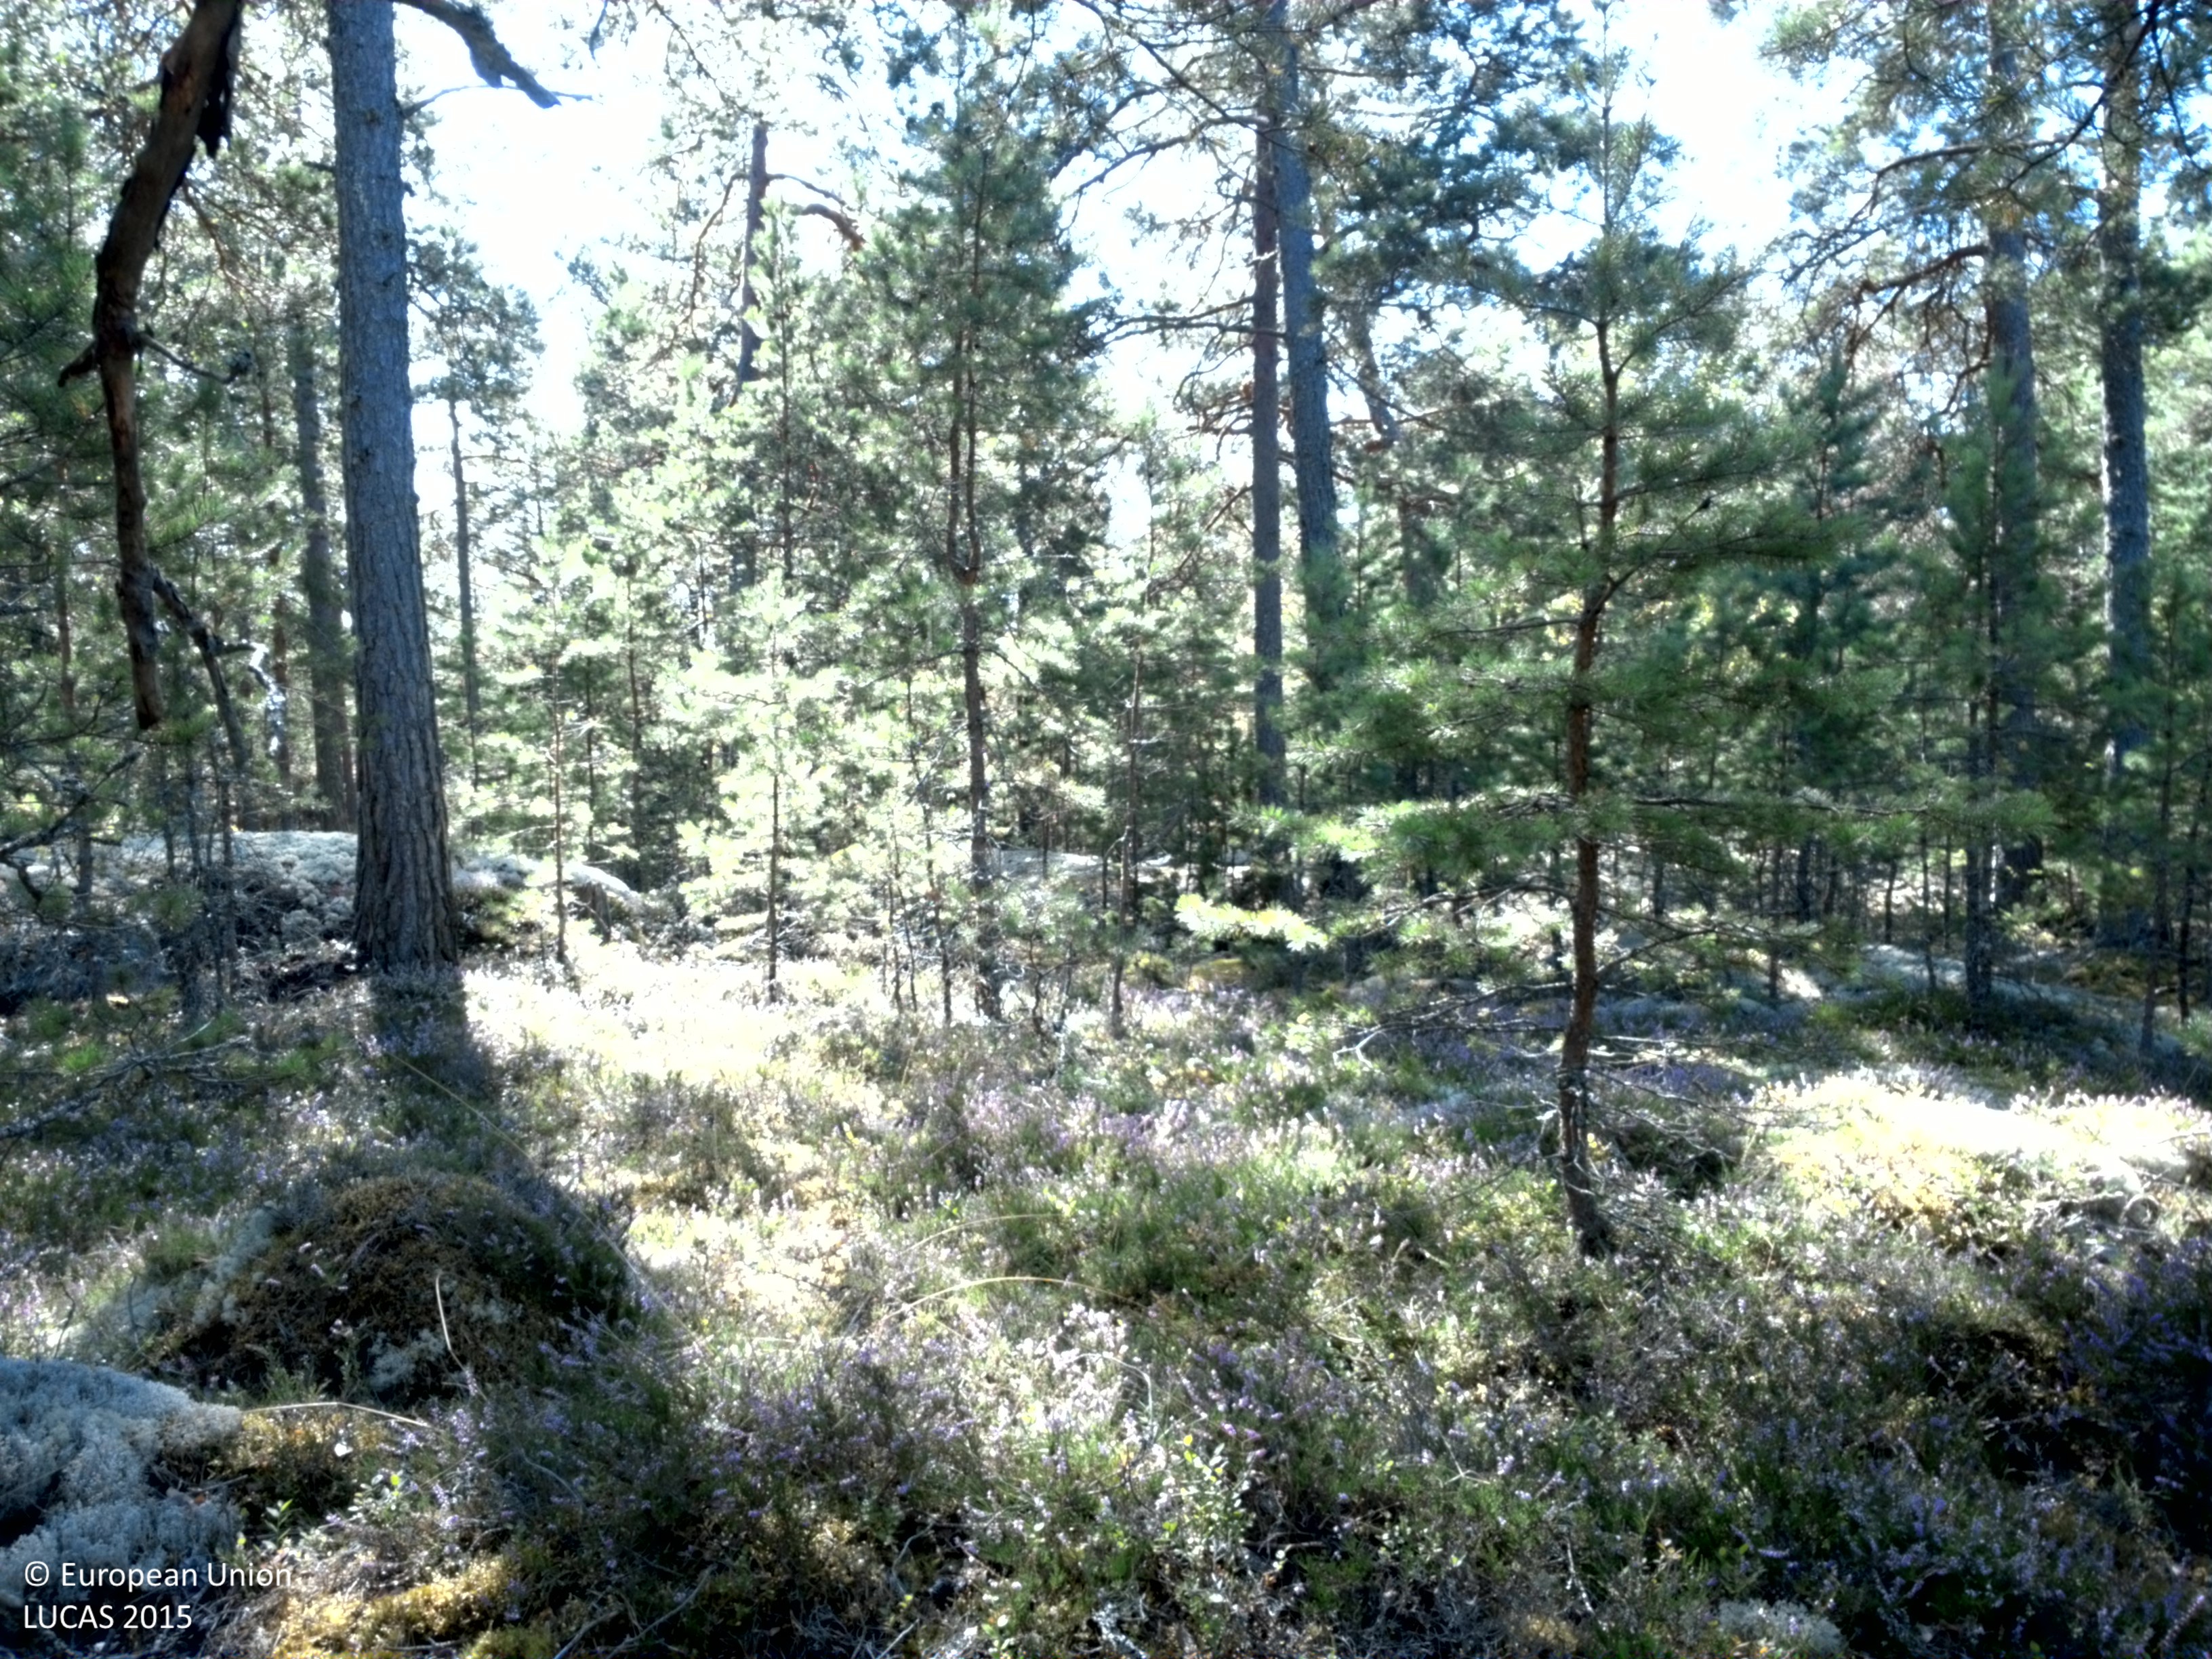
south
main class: Woodland
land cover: Pine dominated coniferous woodland
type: boreal forest
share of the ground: > 75 %
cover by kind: coniferous forest trees 60 %, lichens and mosses 25 %, shrubs 10 %, broadleaved forest trees 5 %
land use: Amenities, museums, leisure
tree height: > 5 m
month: August
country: SE
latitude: 59.4452
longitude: 17.7033
